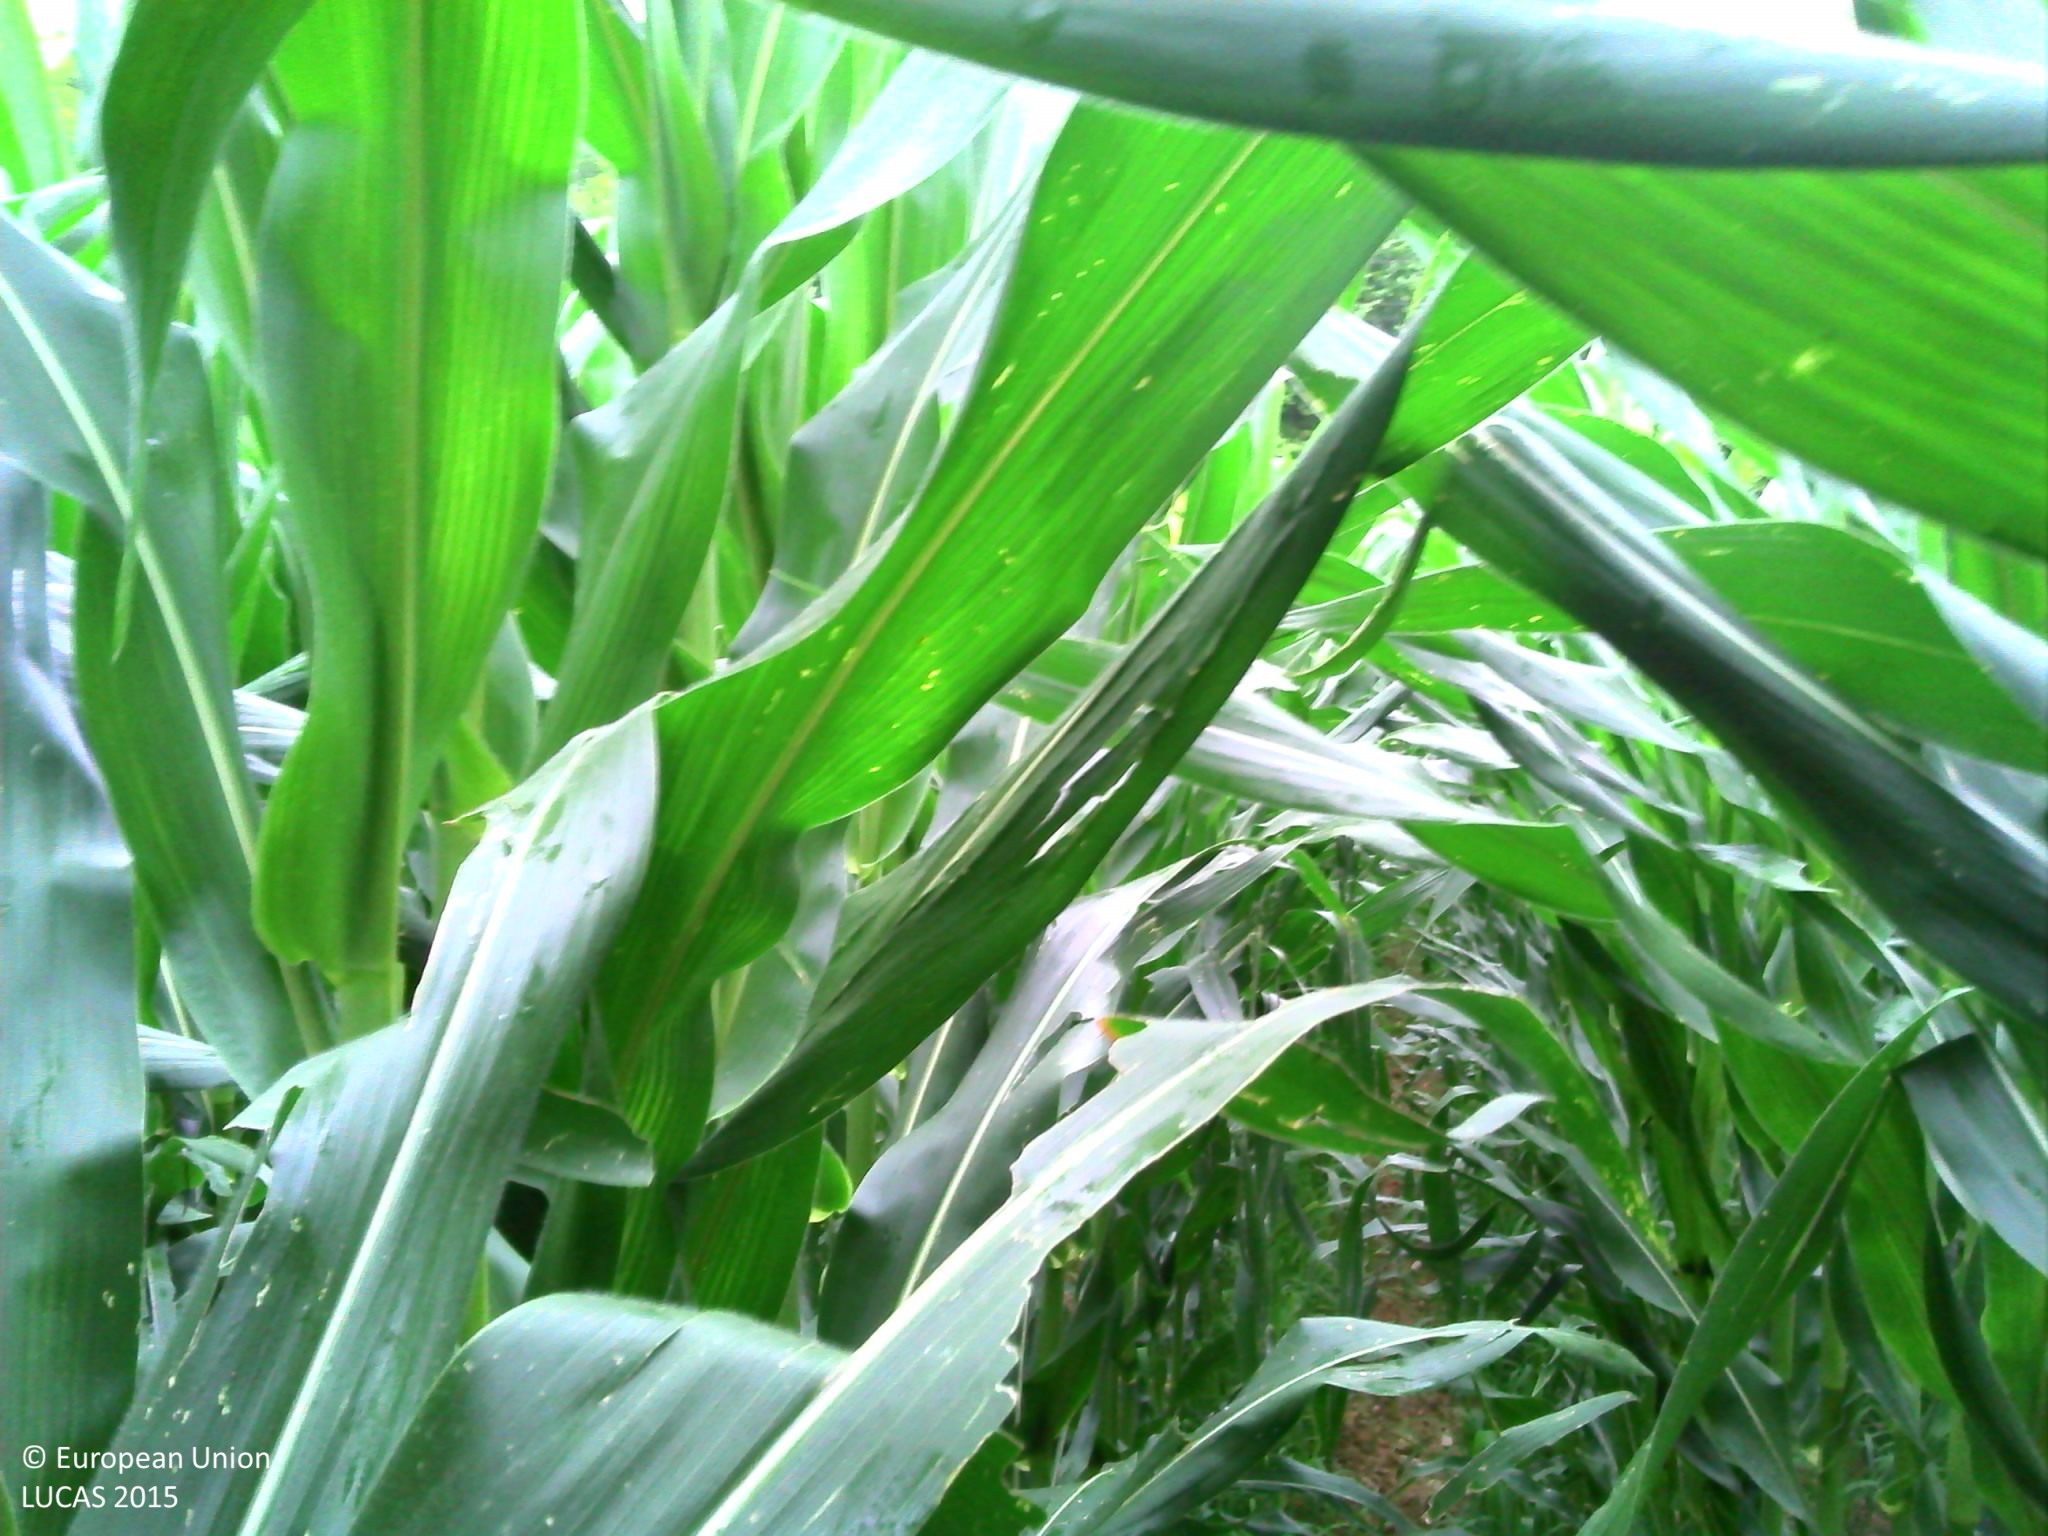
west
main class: Cropland
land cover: Maize
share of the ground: > 75 %
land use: Agriculture (excluding fallow land and kitchen gardens)
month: August
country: FR
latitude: 43.4307
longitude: -1.2197
